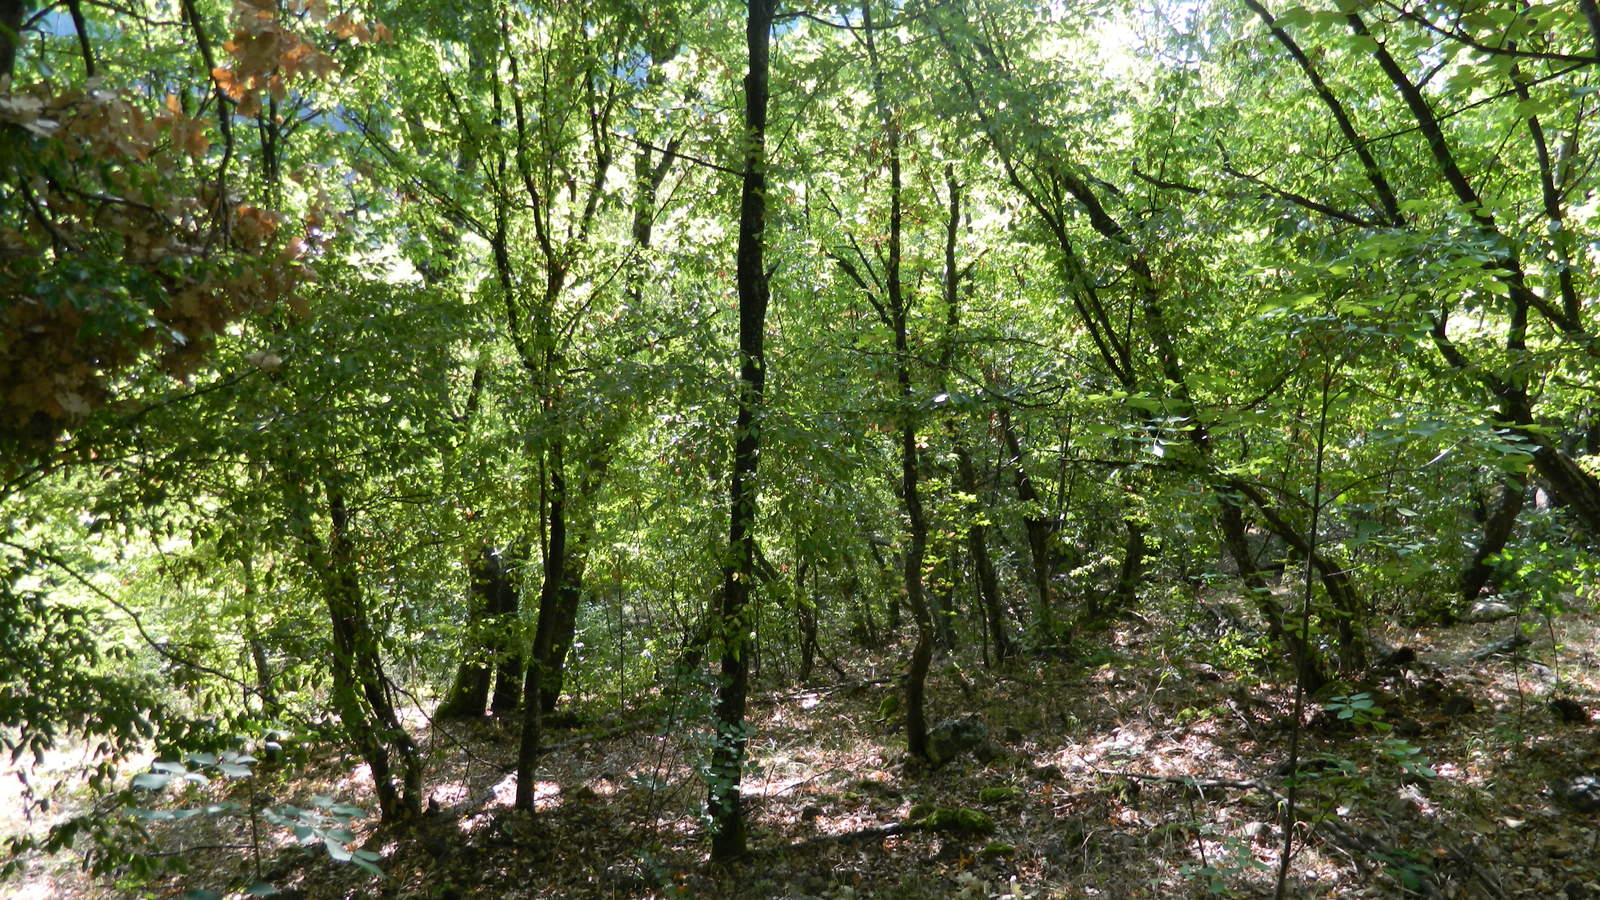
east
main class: Woodland
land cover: Broadleaved woodland
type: mesophytic deciduous forest
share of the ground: > 75 %
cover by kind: broadleaved forest trees 100 %
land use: Forestry
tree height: > 5 m
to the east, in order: Broadleaved woodland; Rivers and streams; Broadleaved woodland; Paved roads, cycling and walking lanes; Grass margins; Rocks and stones; Broadleaved woodland; Tracks; Broadleaved woodland; Shrubland with sparse tree cover; Rocks and stones; Grassland with sparse tree/shrub cover; Rocks and stones; Broadleaved woodland; Rocks and stones; Broadleaved woodland
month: August
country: BG
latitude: 41.6566
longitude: 25.8334
